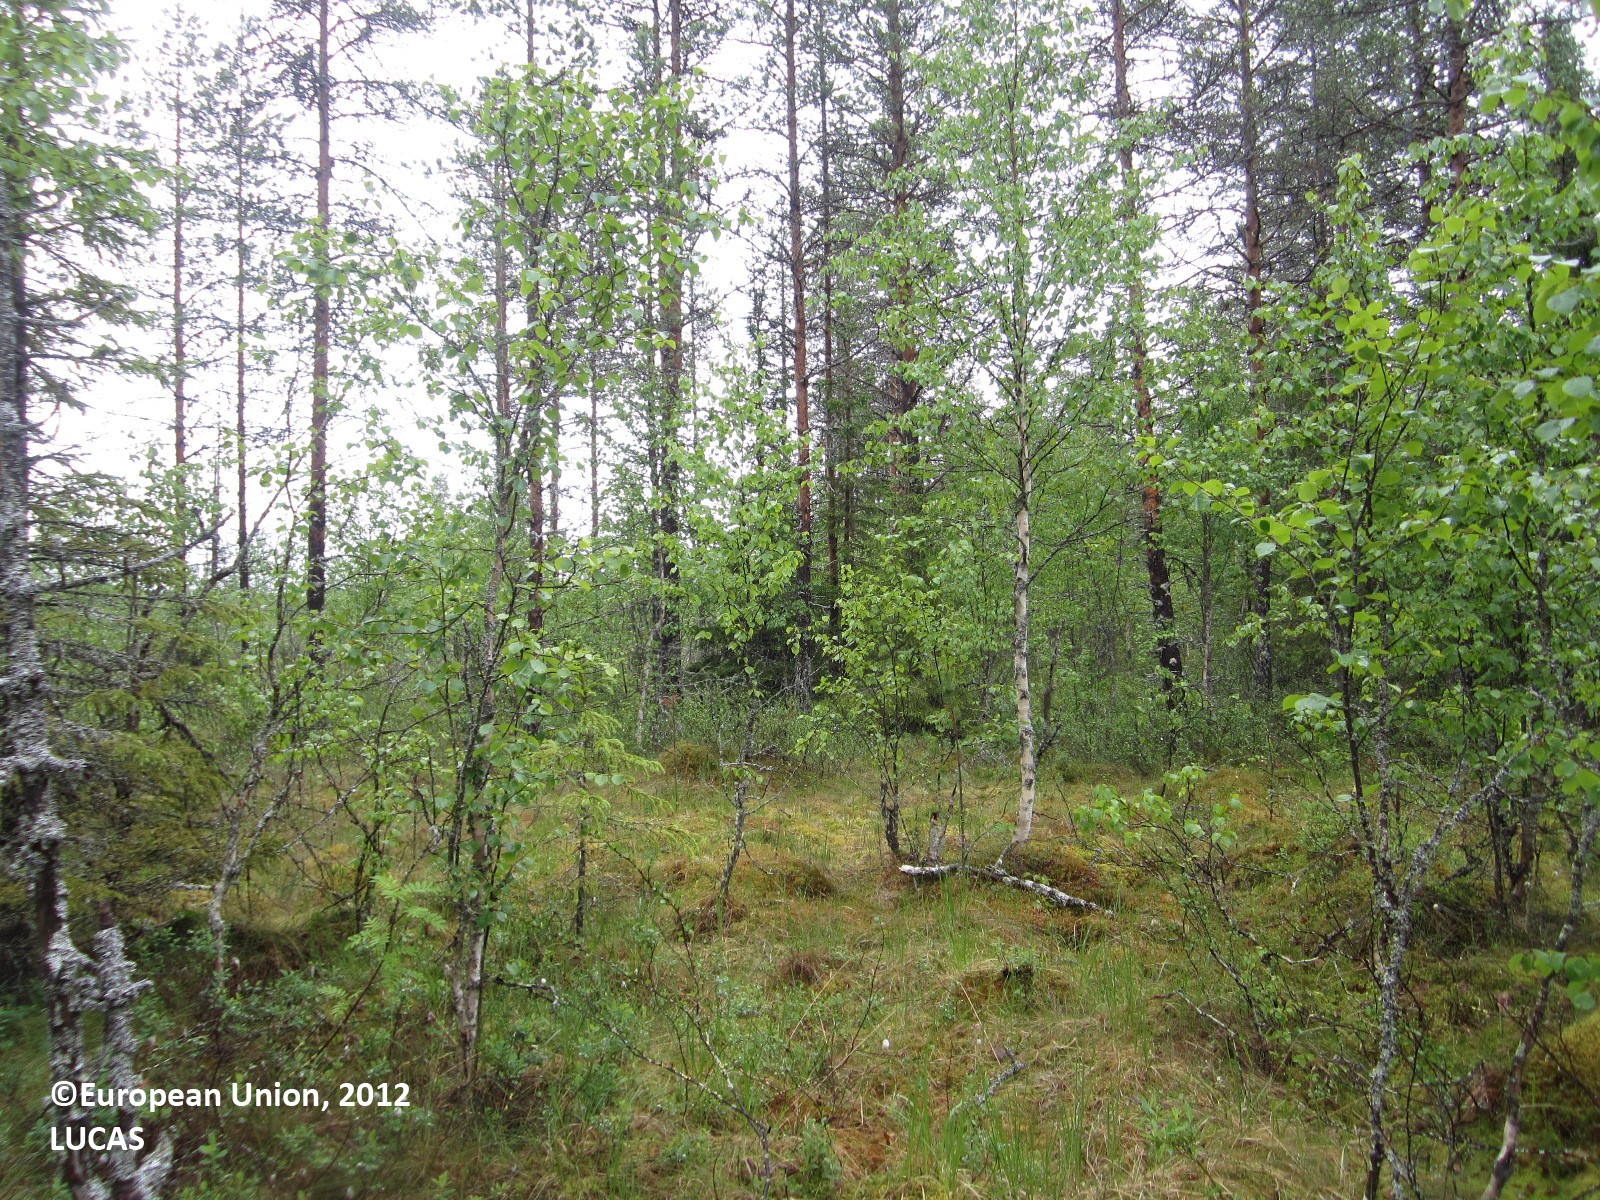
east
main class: Woodland
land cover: Pine dominated mixed woodland
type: boreal forest
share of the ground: 50 - 75 %
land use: Forestry
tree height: > 5 m
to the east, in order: Pine dominated mixed woodland; Broadleaved woodland; Shrubland without tree cover; Broadleaved woodland; Ditches and canals; Spontaneously vegetated surfaces; Shrubland with sparse tree cover; Spruce dominated coniferous woodland; Shrubland with sparse tree cover; Ditches and canals; Broadleaved woodland; Spontaneously vegetated surfaces
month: June
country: FI
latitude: 64.6151
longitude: 29.7701
